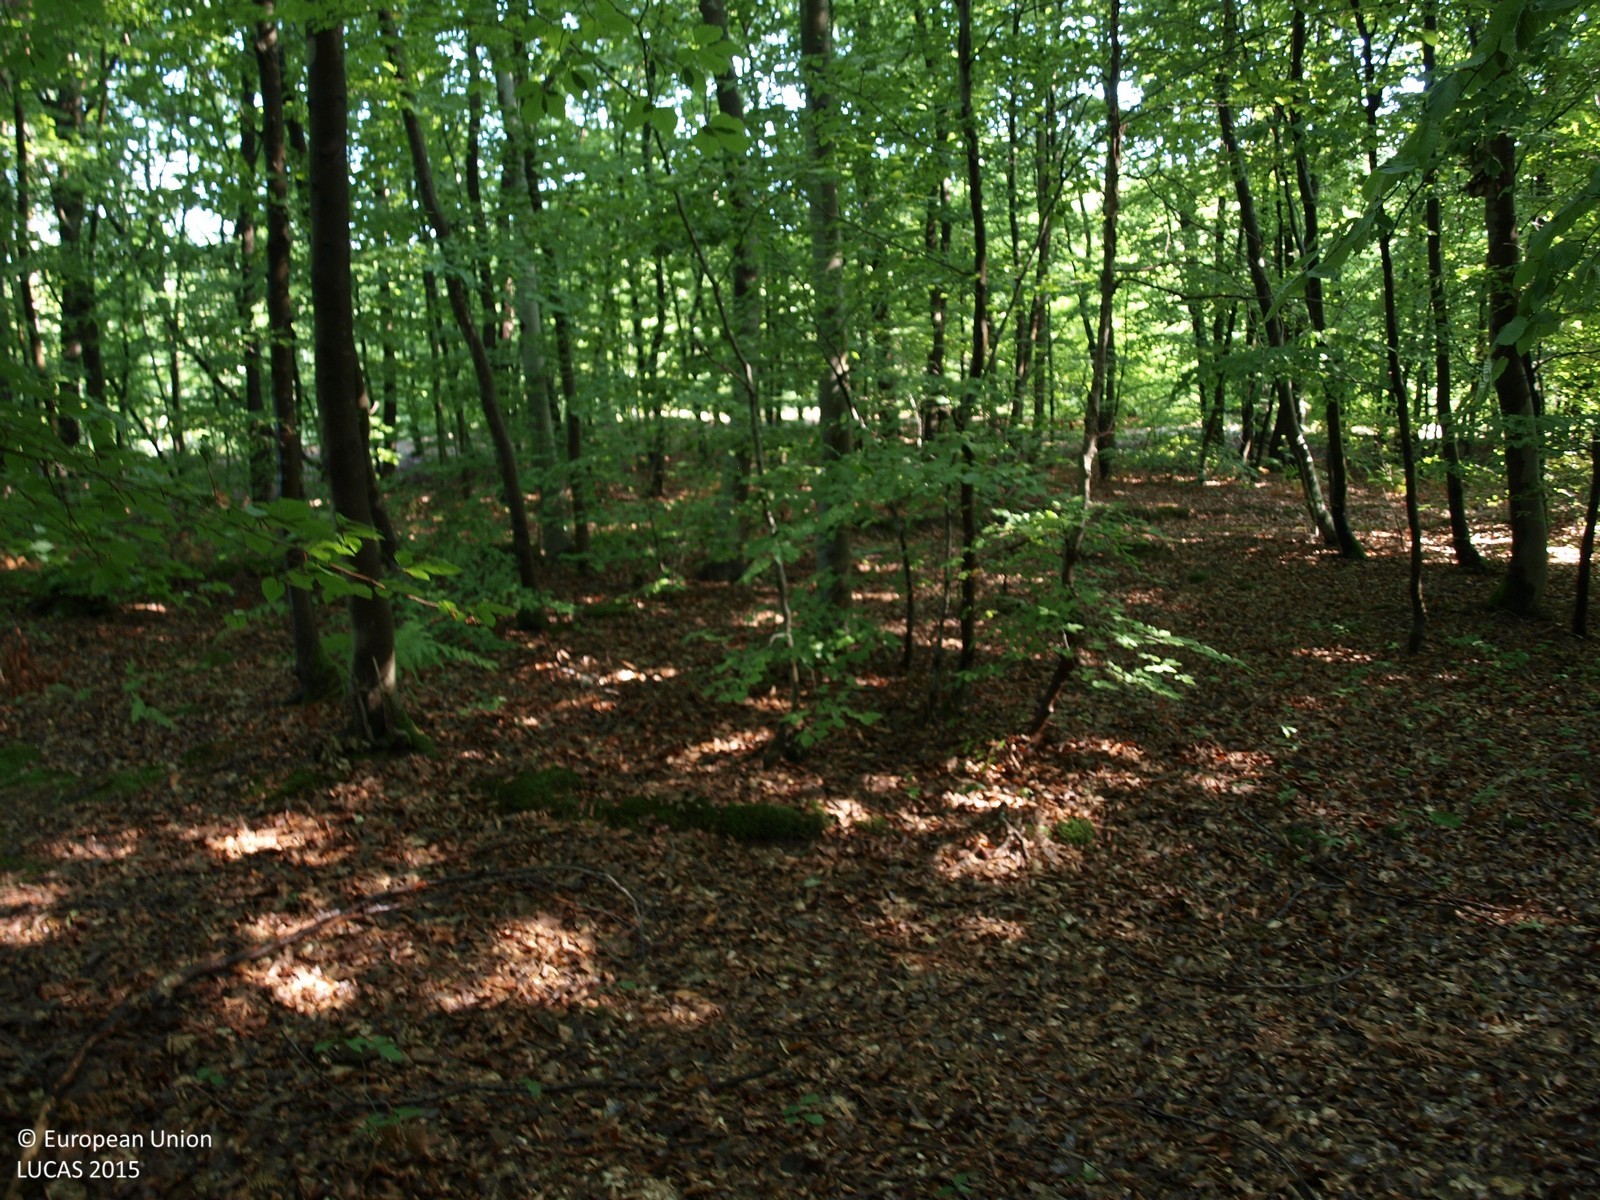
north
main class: Woodland
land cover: Broadleaved woodland
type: beech forest
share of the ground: > 75 %
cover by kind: broadleaved forest trees 100 %
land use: Forestry
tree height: > 5 m
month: July
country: HR
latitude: 46.0558
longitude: 16.0089
